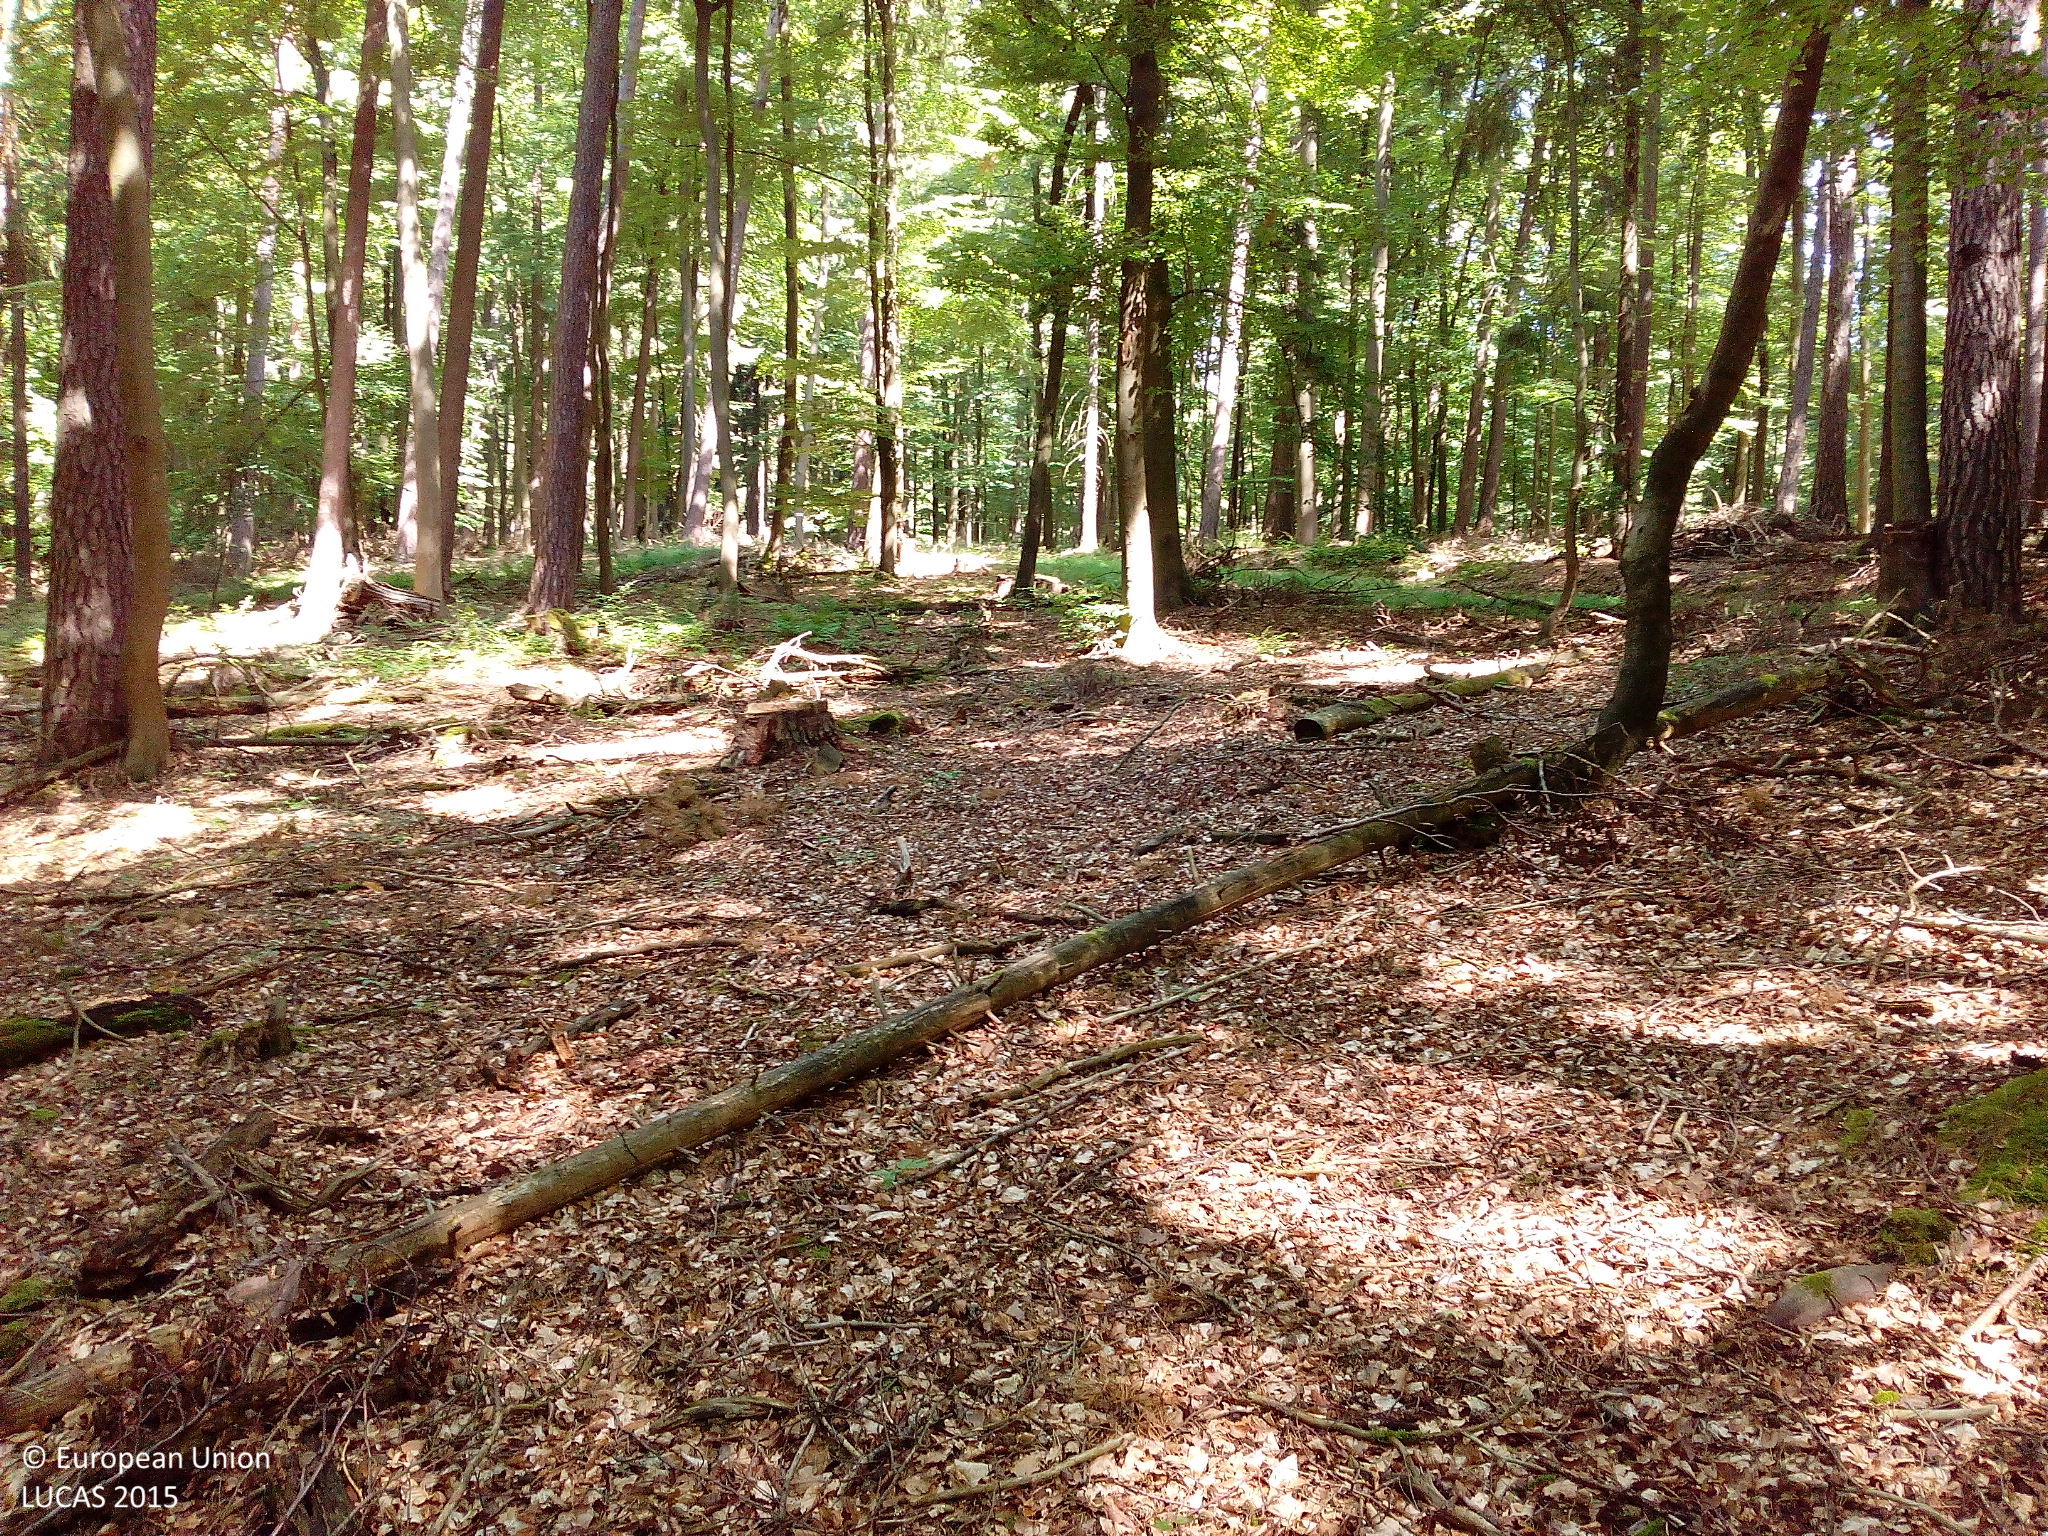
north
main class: Woodland
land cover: Spruce dominated mixed woodland
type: hemiboreal forest and nemoral coniferous forest and mixed broadleaved-coniferous forest
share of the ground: > 75 %
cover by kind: broadleaved forest trees 65 %, coniferous forest trees 35 %
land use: Forestry
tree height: > 5 m
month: July
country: DE
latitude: 50.9753
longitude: 9.9573
